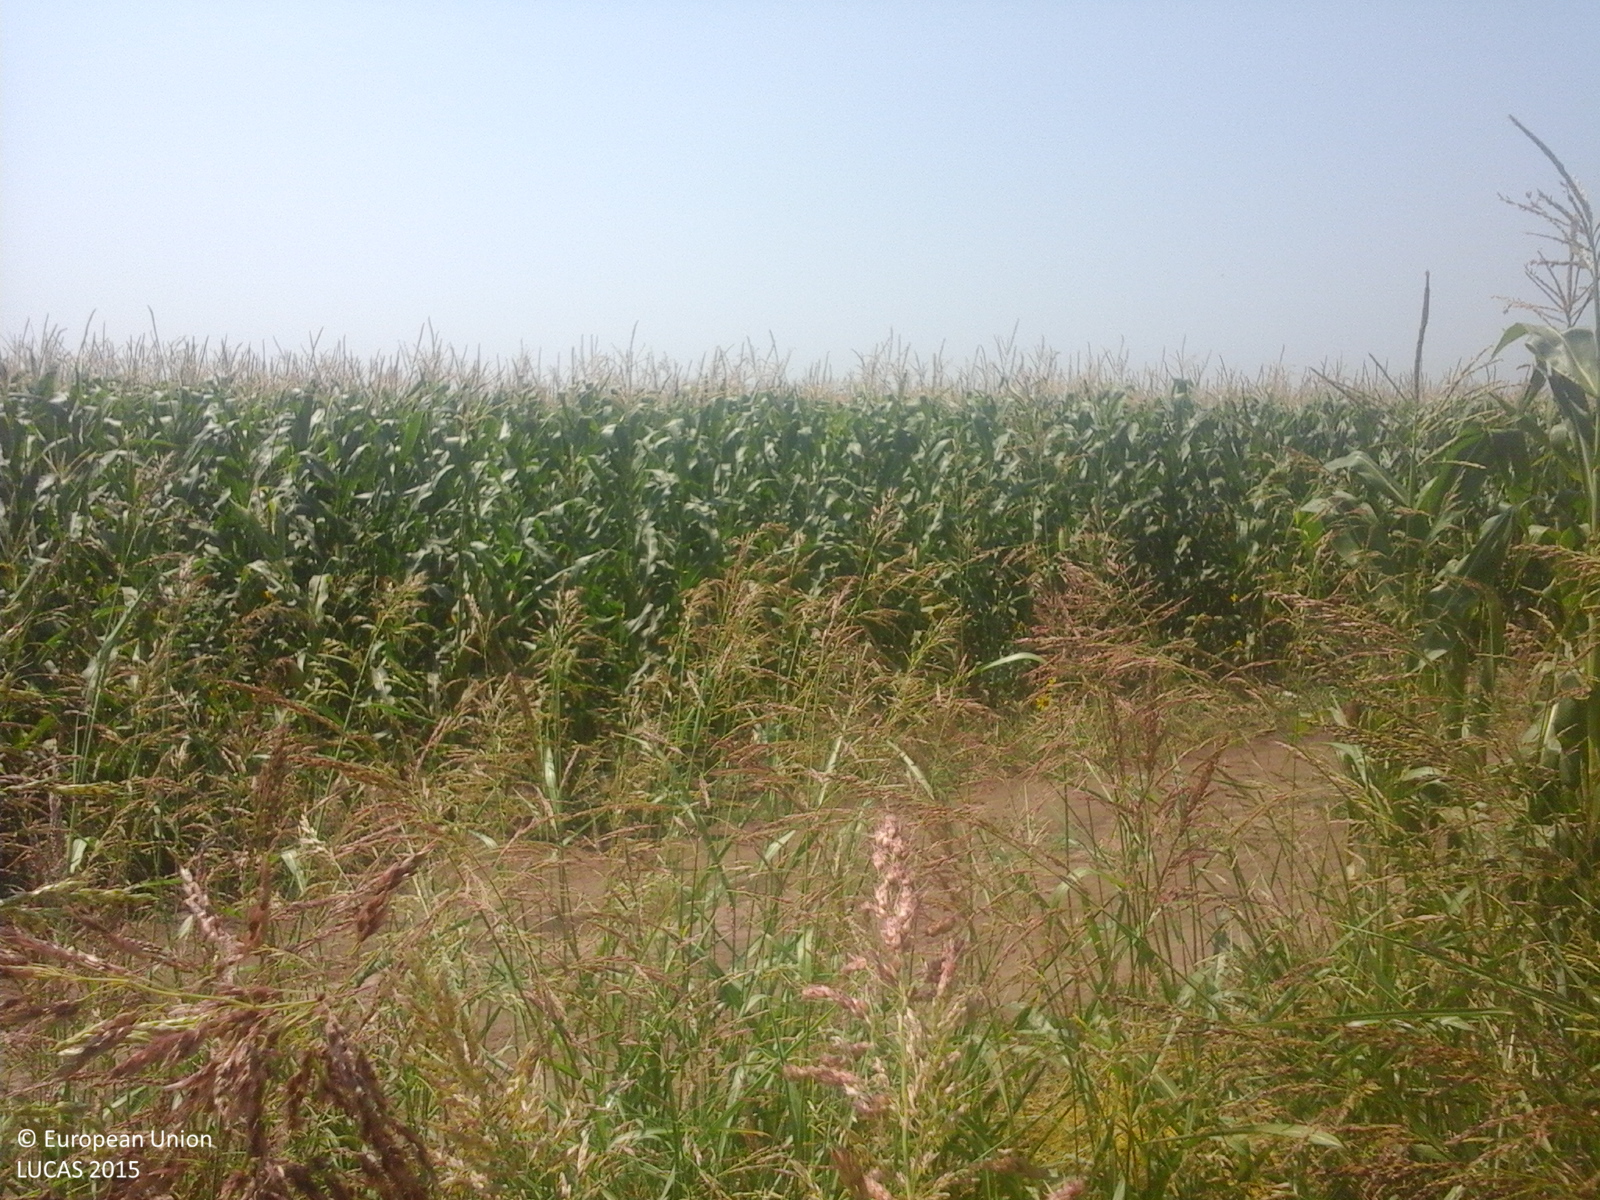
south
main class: Cropland
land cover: Maize
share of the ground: > 75 %
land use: Agriculture (excluding fallow land and kitchen gardens)
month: August
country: RO
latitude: 45.1814
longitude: 27.7582
